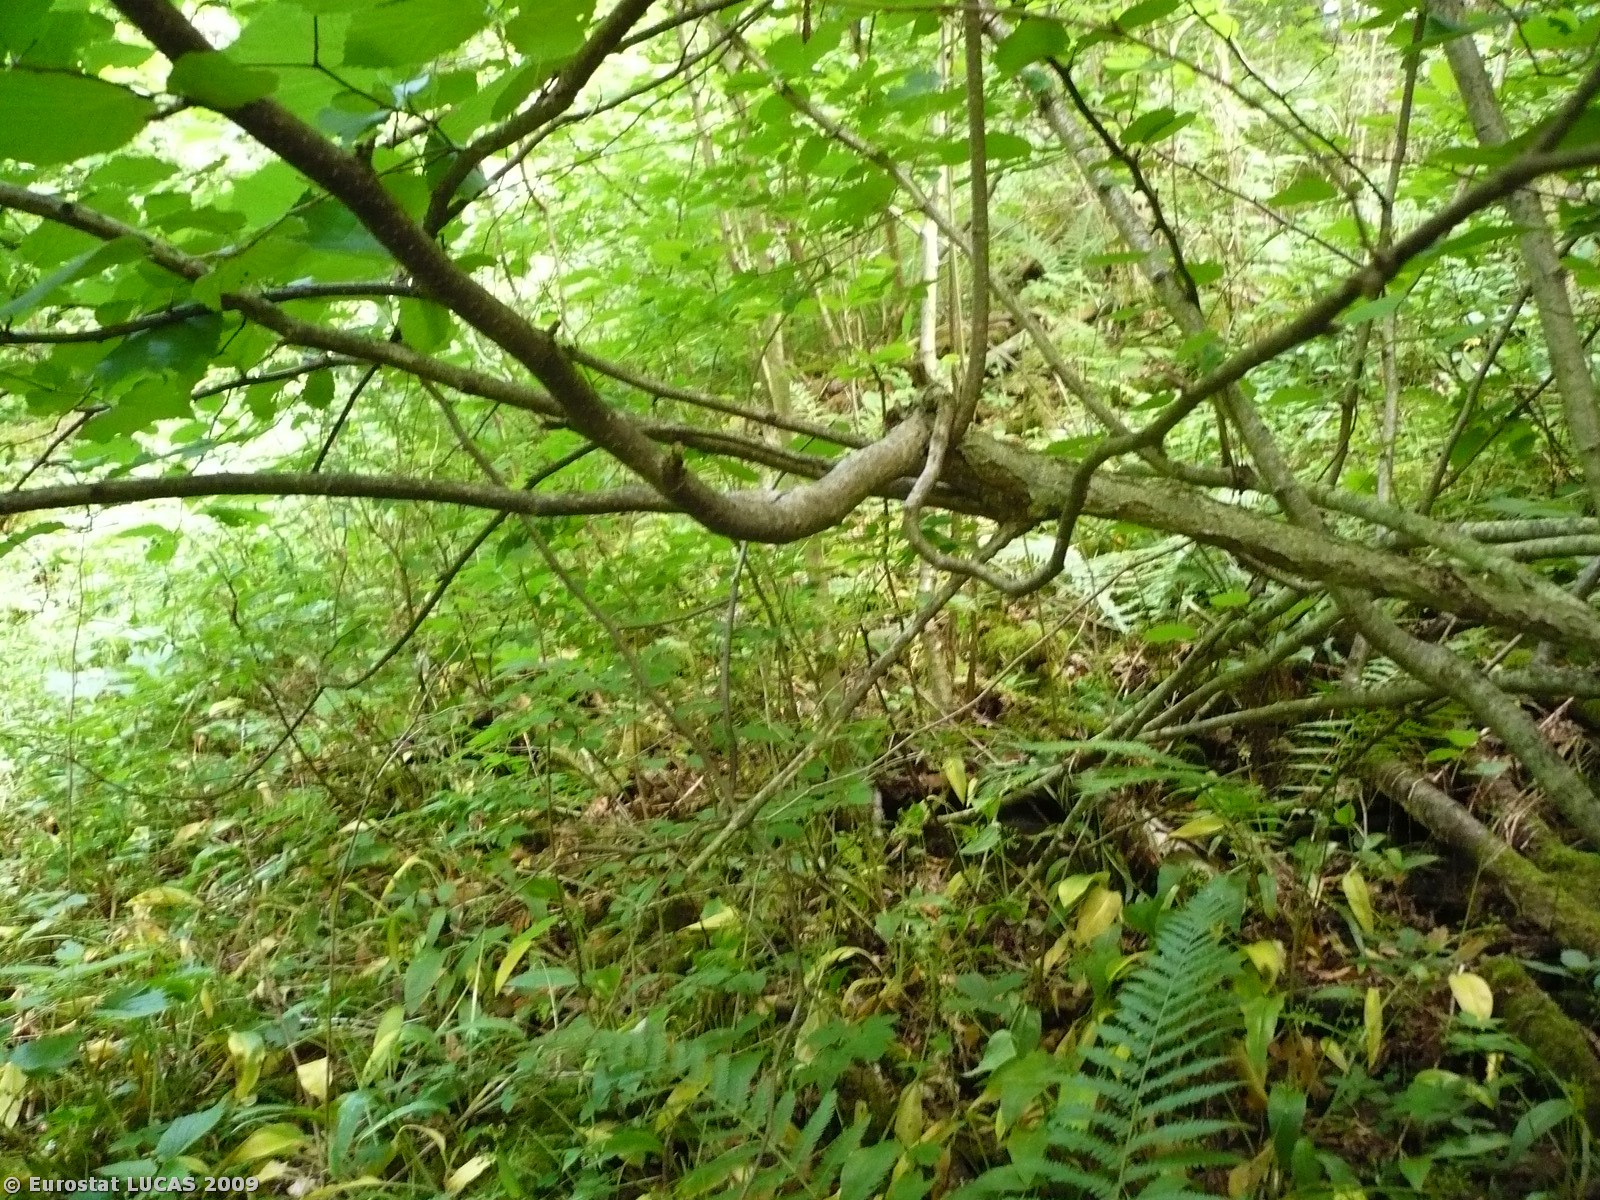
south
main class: Woodland
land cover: Mixed woodland
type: beech forest
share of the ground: > 75 %
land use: Forestry
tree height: > 5 m
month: June
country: SI
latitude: 45.7996
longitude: 14.2031
